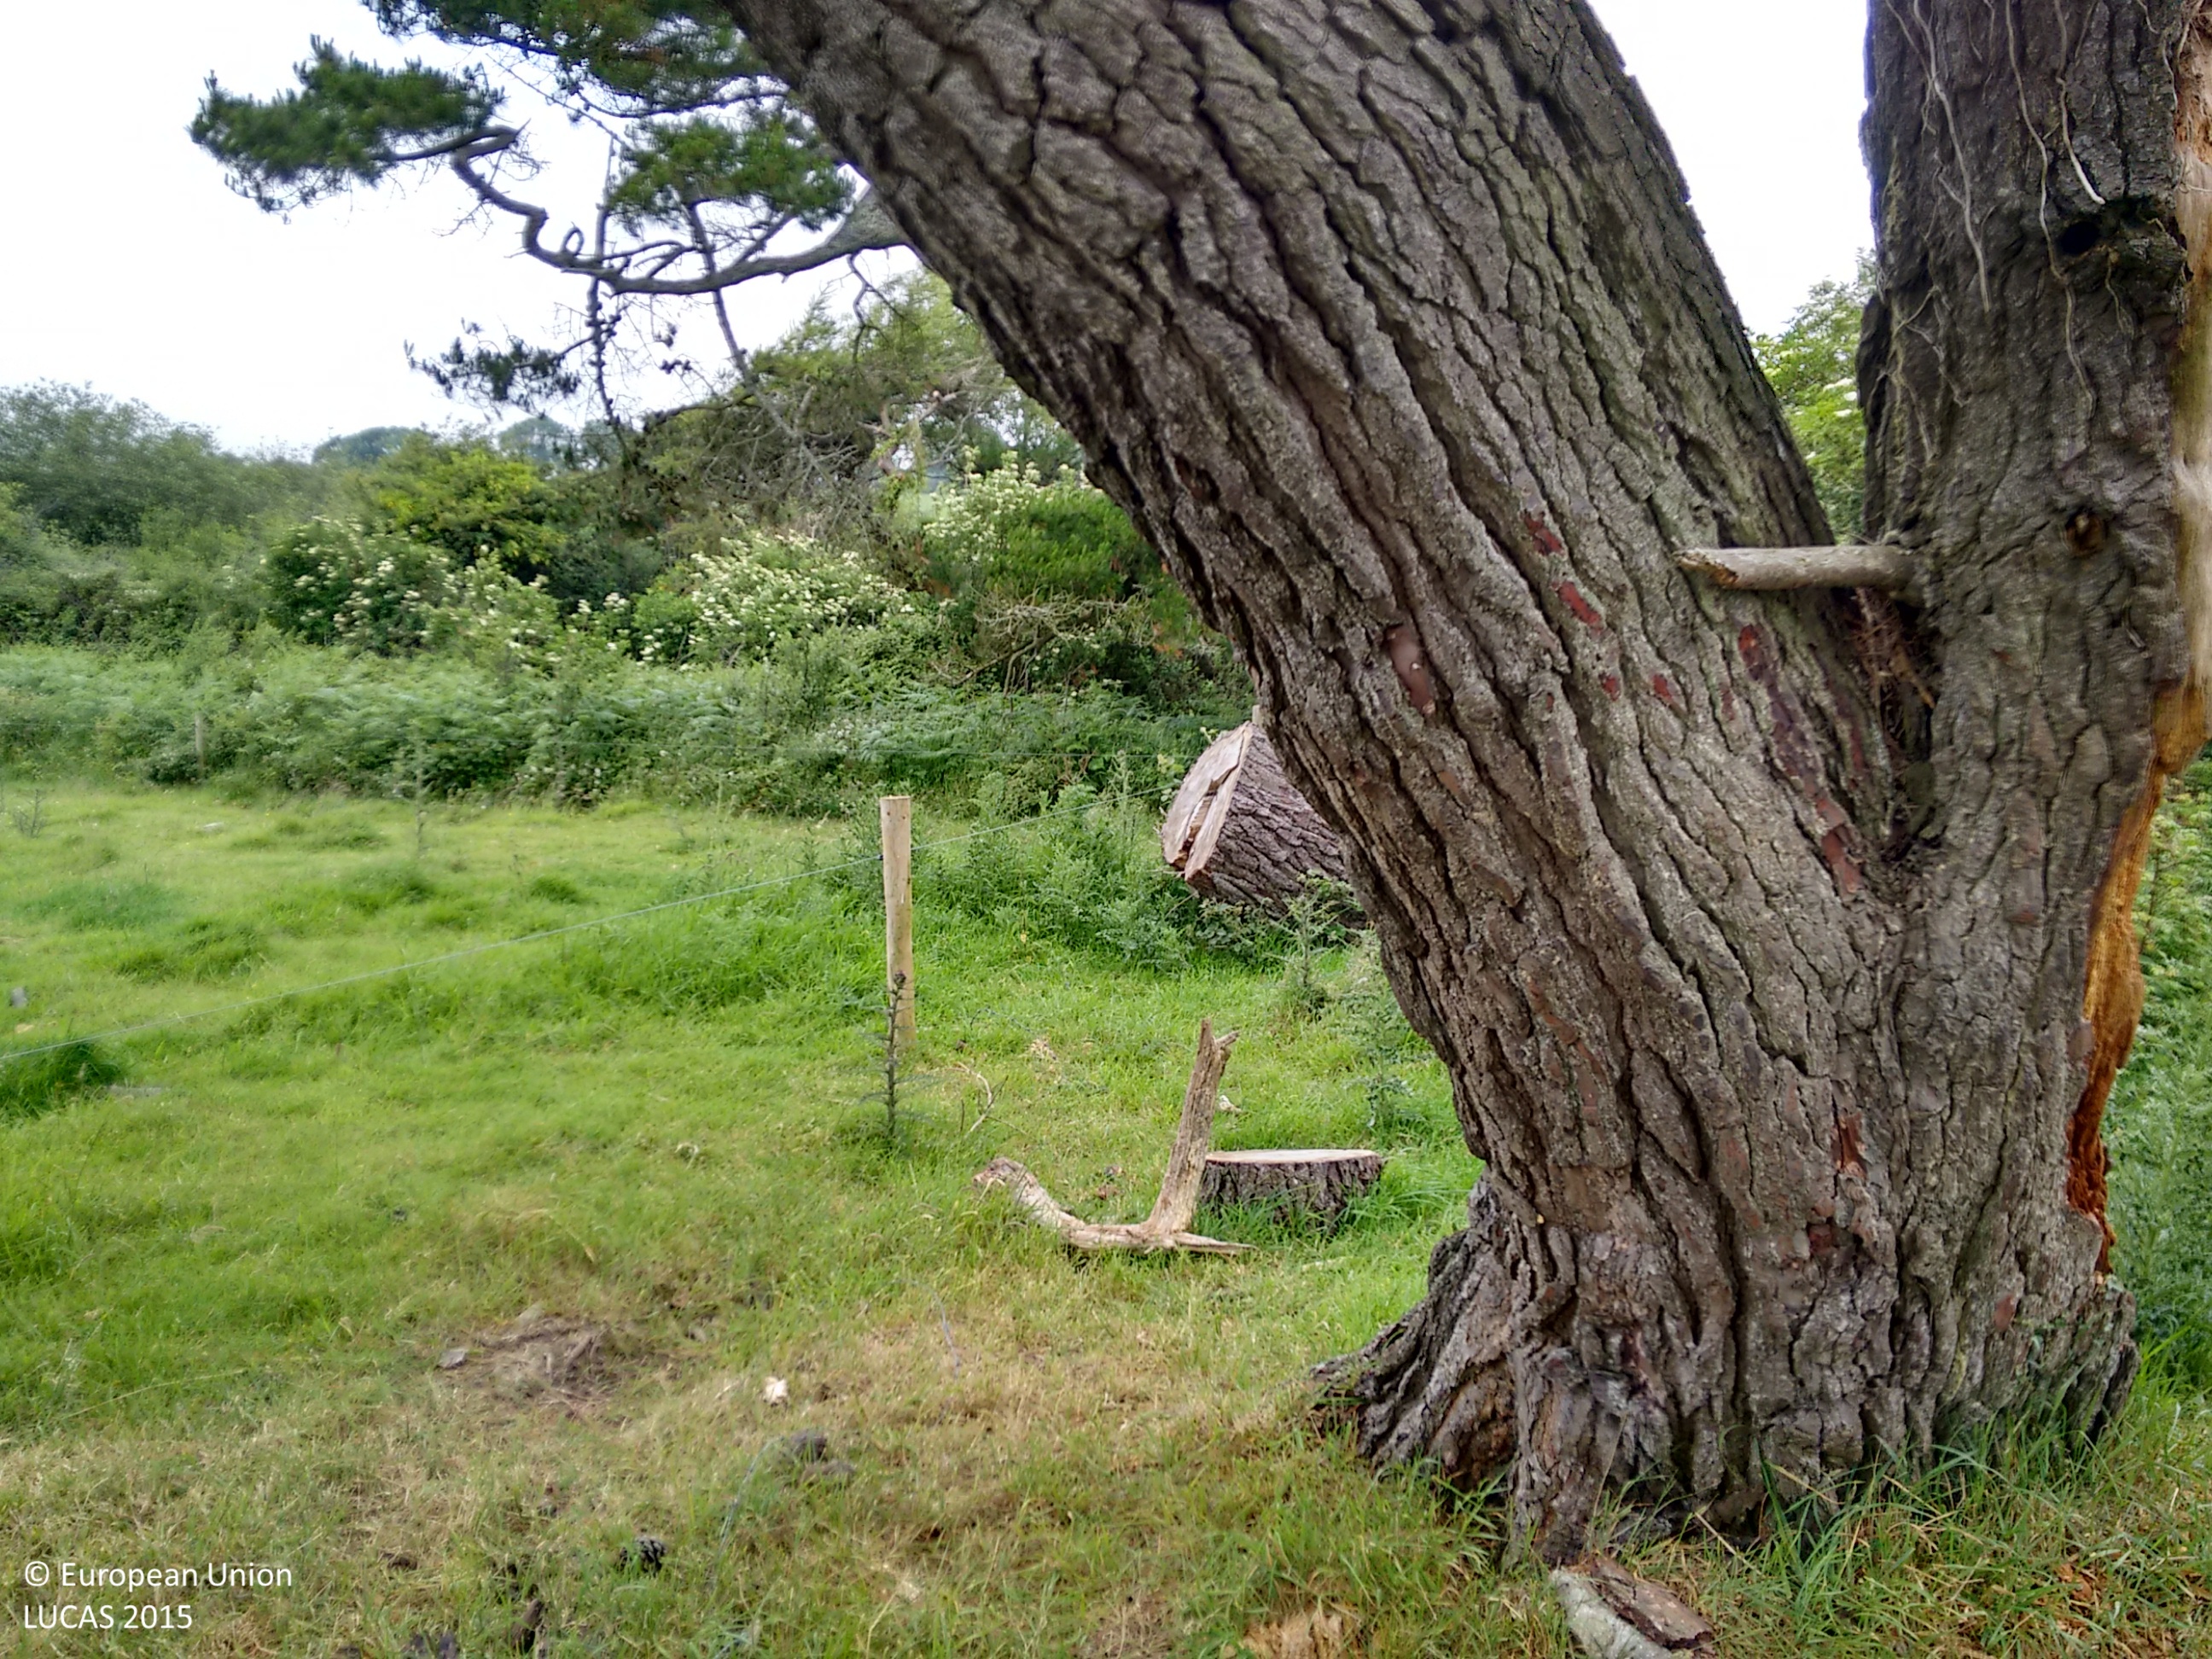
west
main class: Grassland
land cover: Grassland with sparse tree/shrub cover
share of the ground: > 75 %
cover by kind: herbaceous plants 95 %, coniferous forest trees 5 %
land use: Agriculture (excluding fallow land and kitchen gardens)
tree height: > 5 m
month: June
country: IE
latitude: 52.1904
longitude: -7.1001
